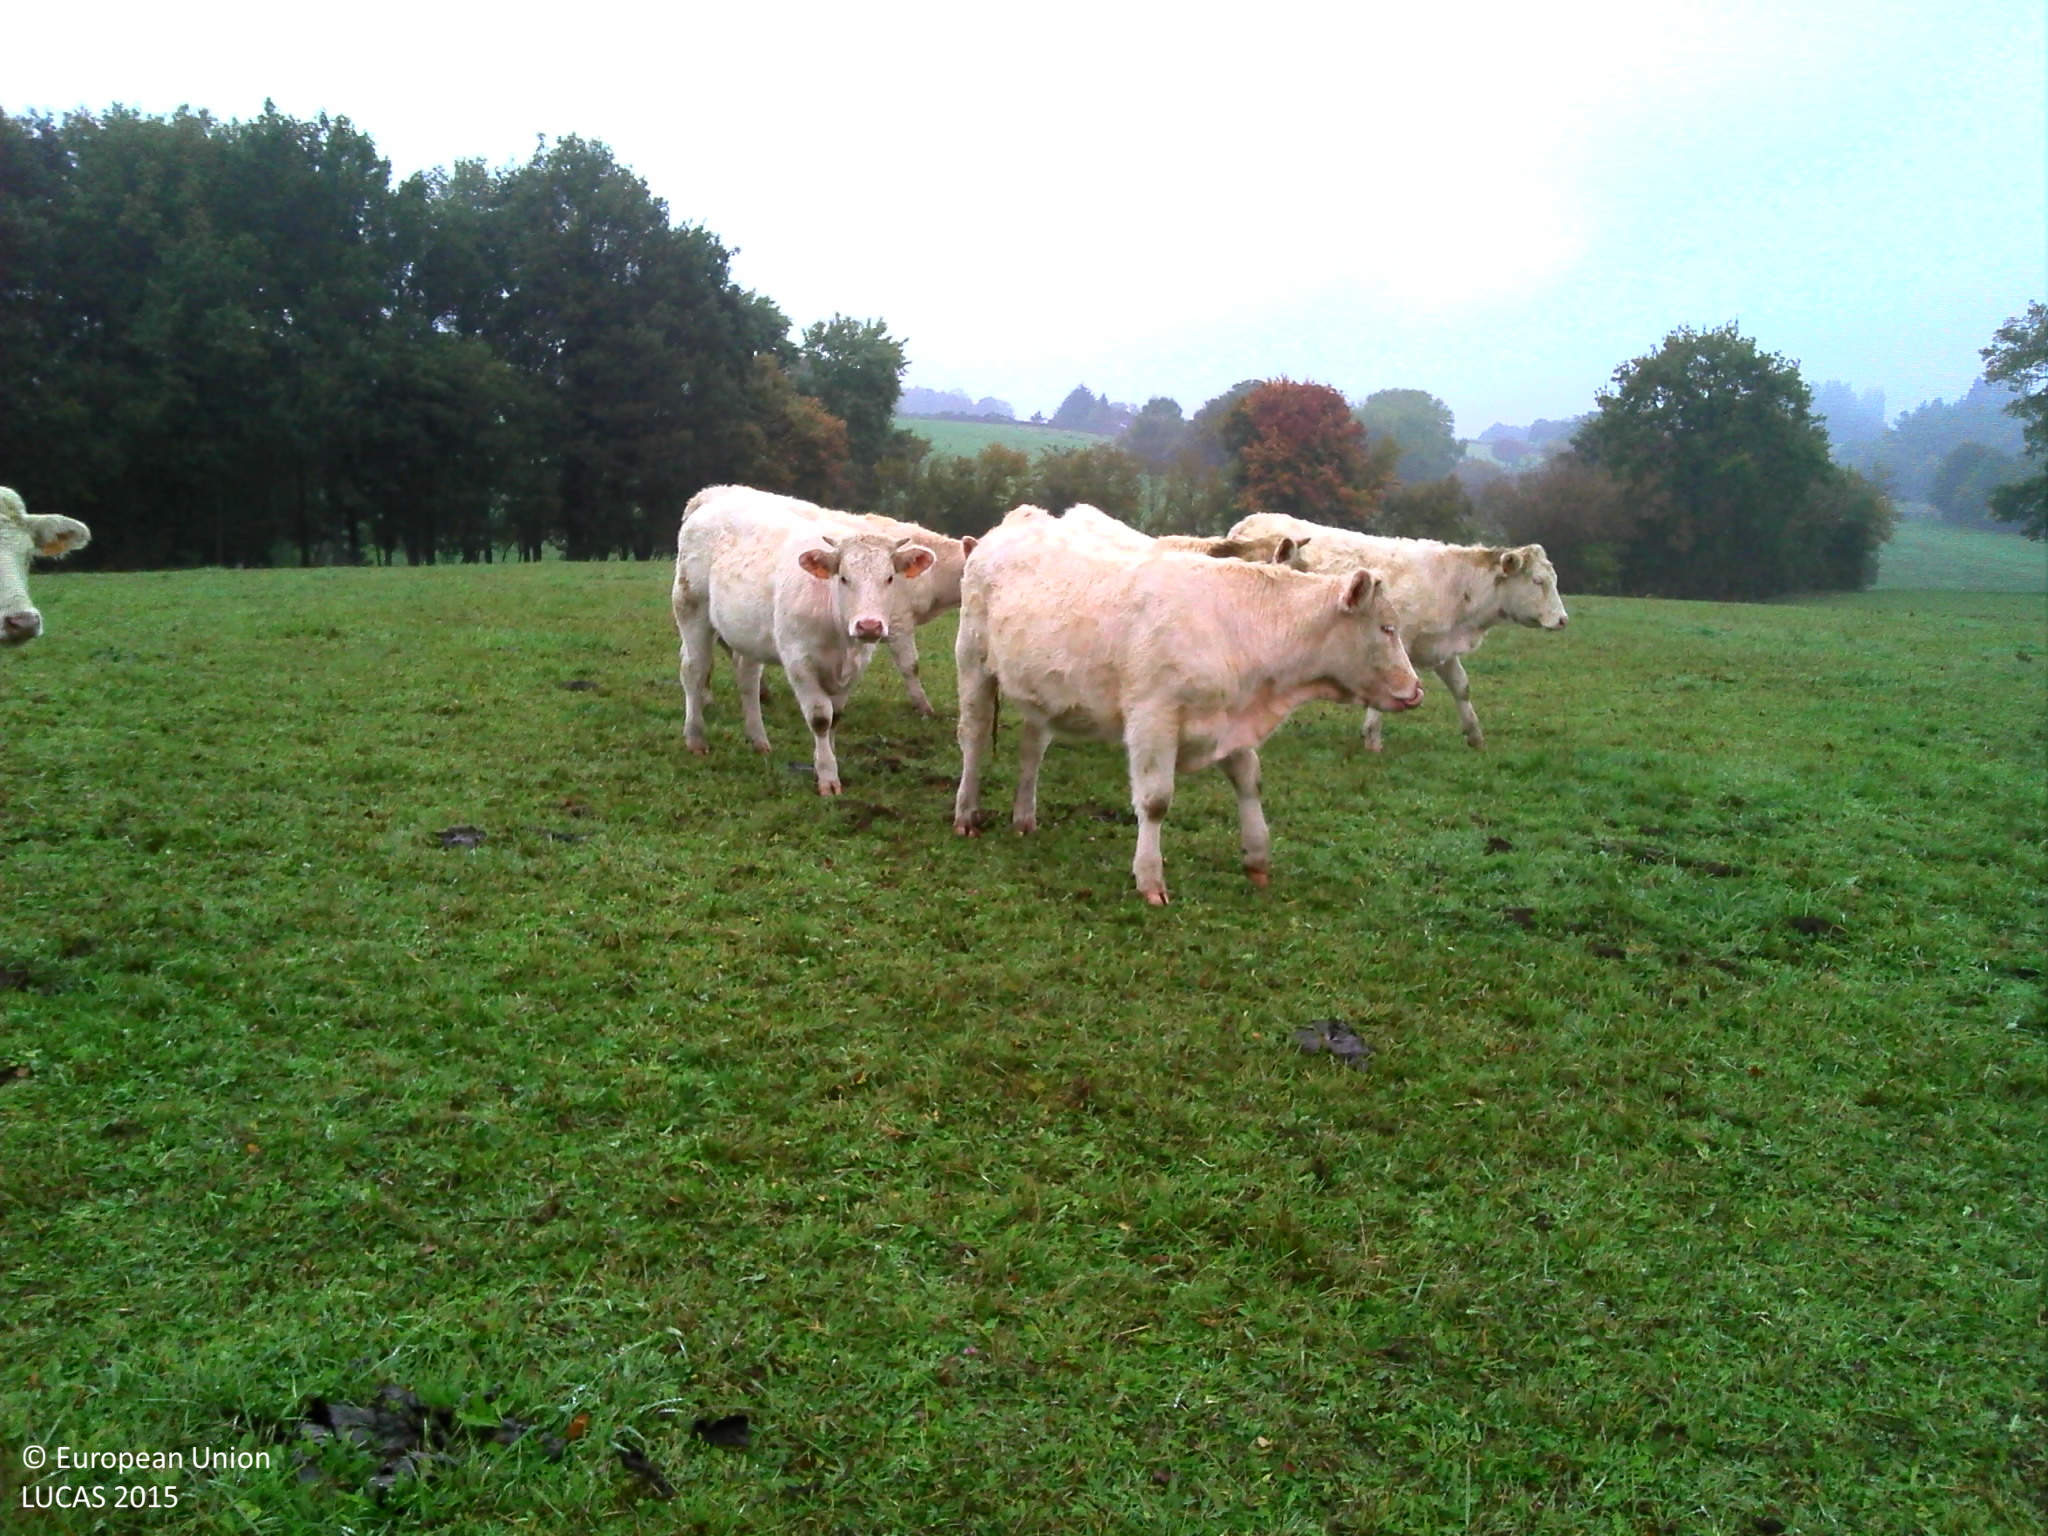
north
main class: Grassland
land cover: Grassland without tree/shrub cover
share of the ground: > 75 %
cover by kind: herbaceous plants 100 %
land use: Agriculture (excluding fallow land and kitchen gardens)
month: October
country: FR
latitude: 45.9500
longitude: 2.8642
